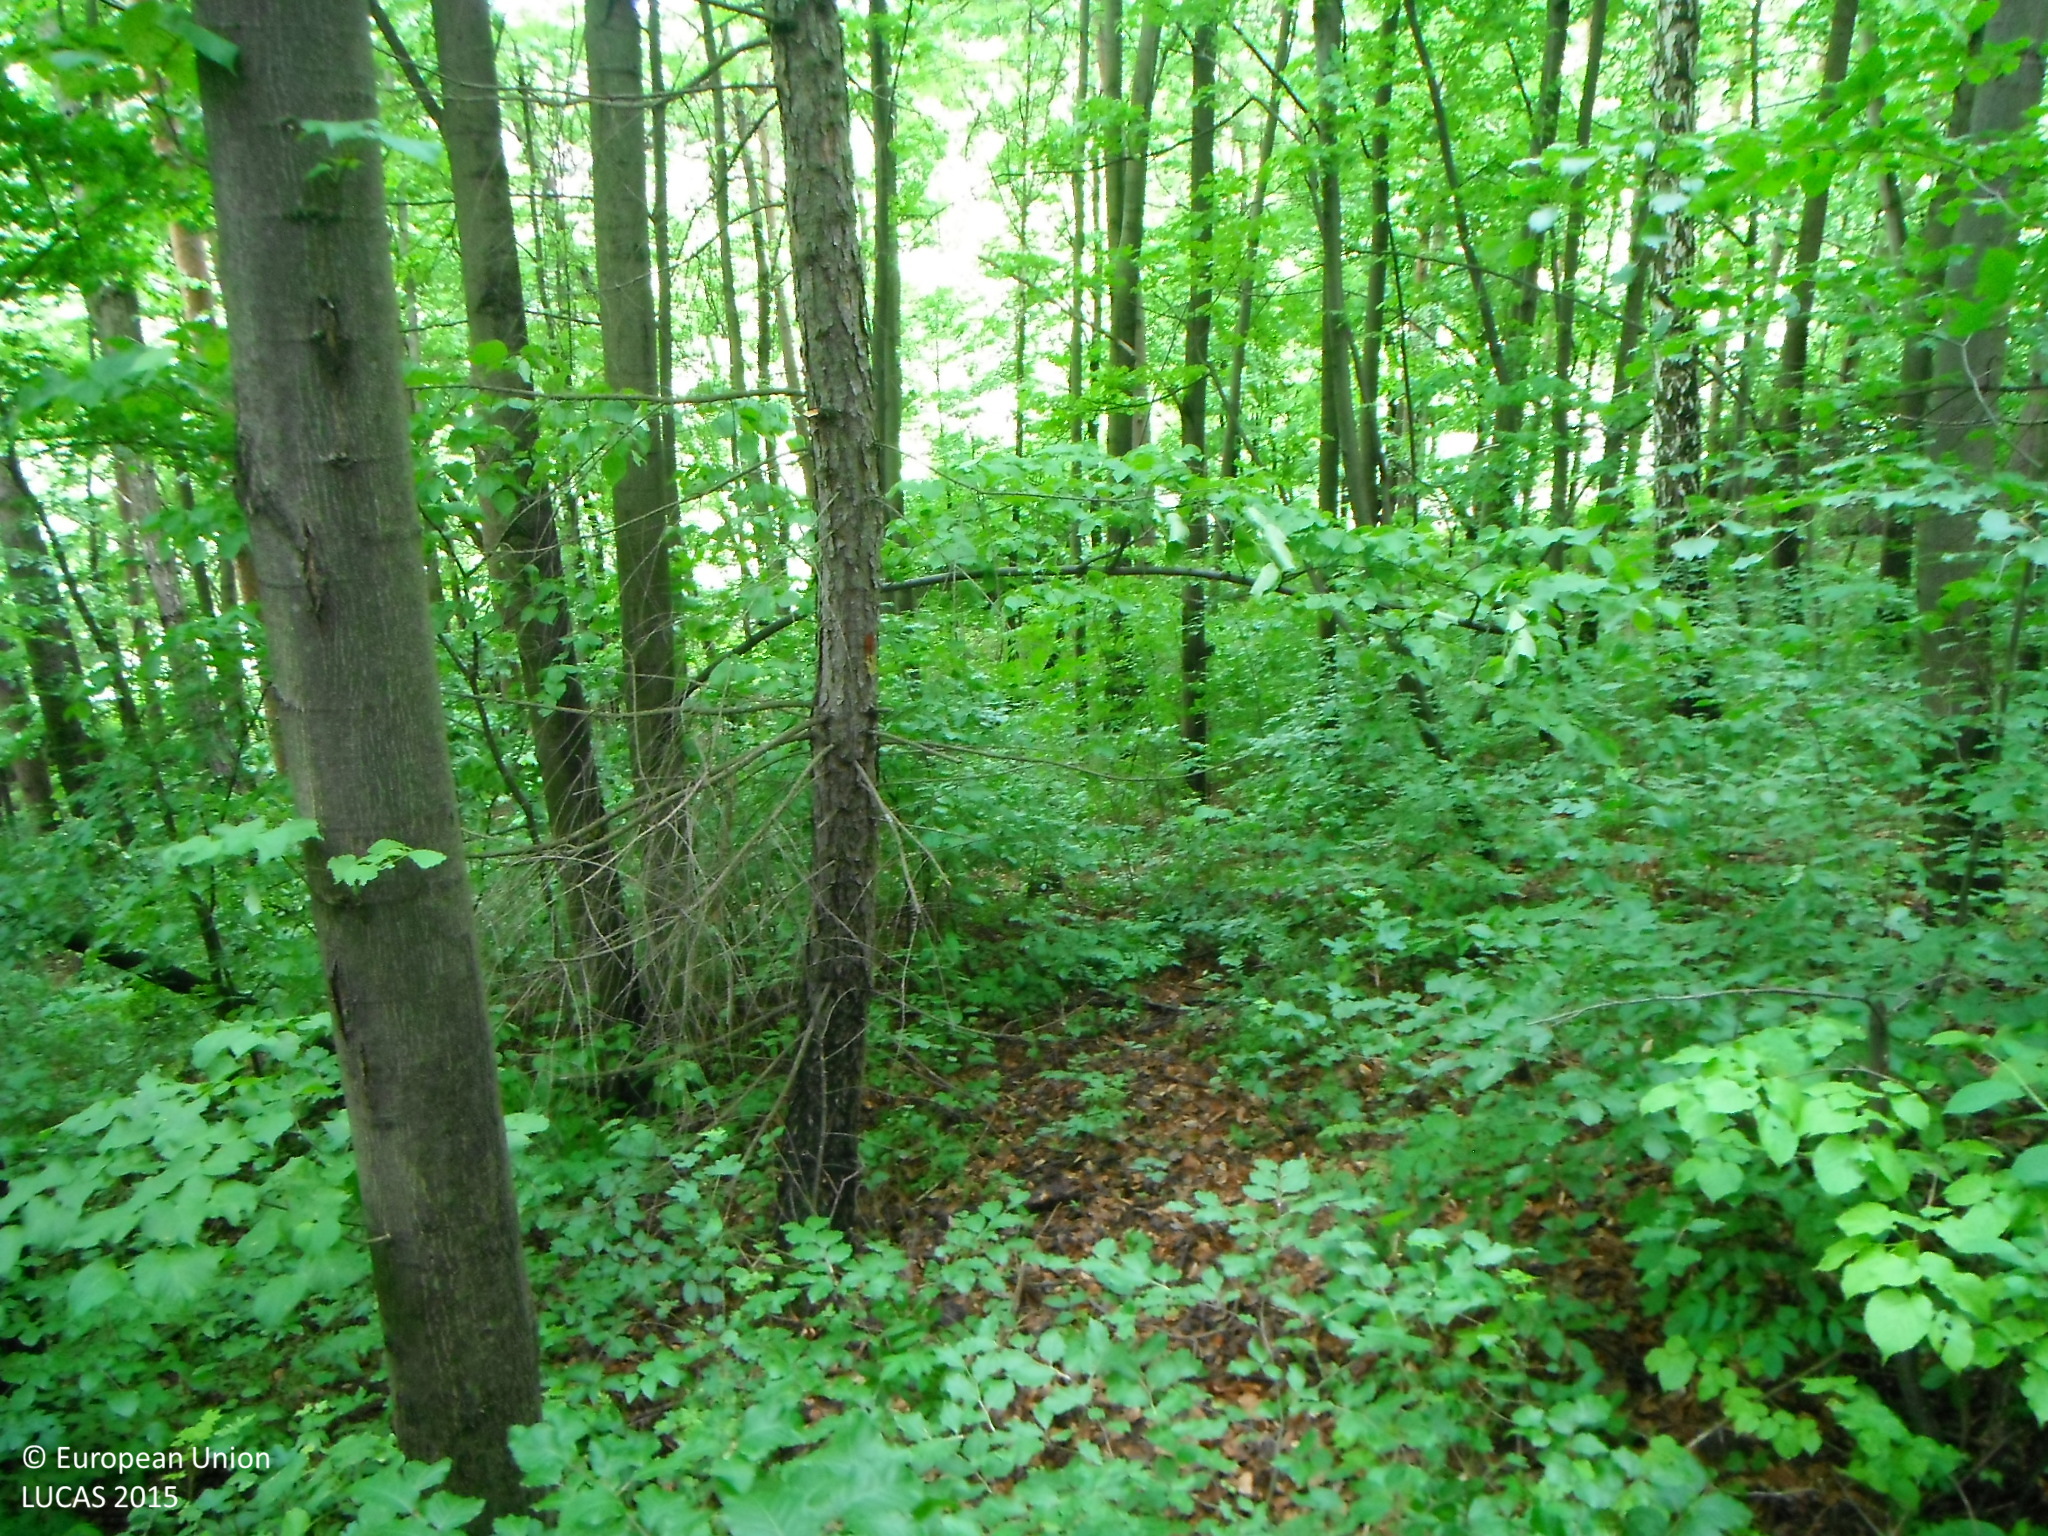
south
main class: Woodland
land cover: Other mixed woodland
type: hemiboreal forest and nemoral coniferous forest and mixed broadleaved-coniferous forest
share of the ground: > 75 %
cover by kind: broadleaved forest trees 60 %, coniferous forest trees 40 %
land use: Forestry
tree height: > 5 m
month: May
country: SK
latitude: 48.7300
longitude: 19.1448
